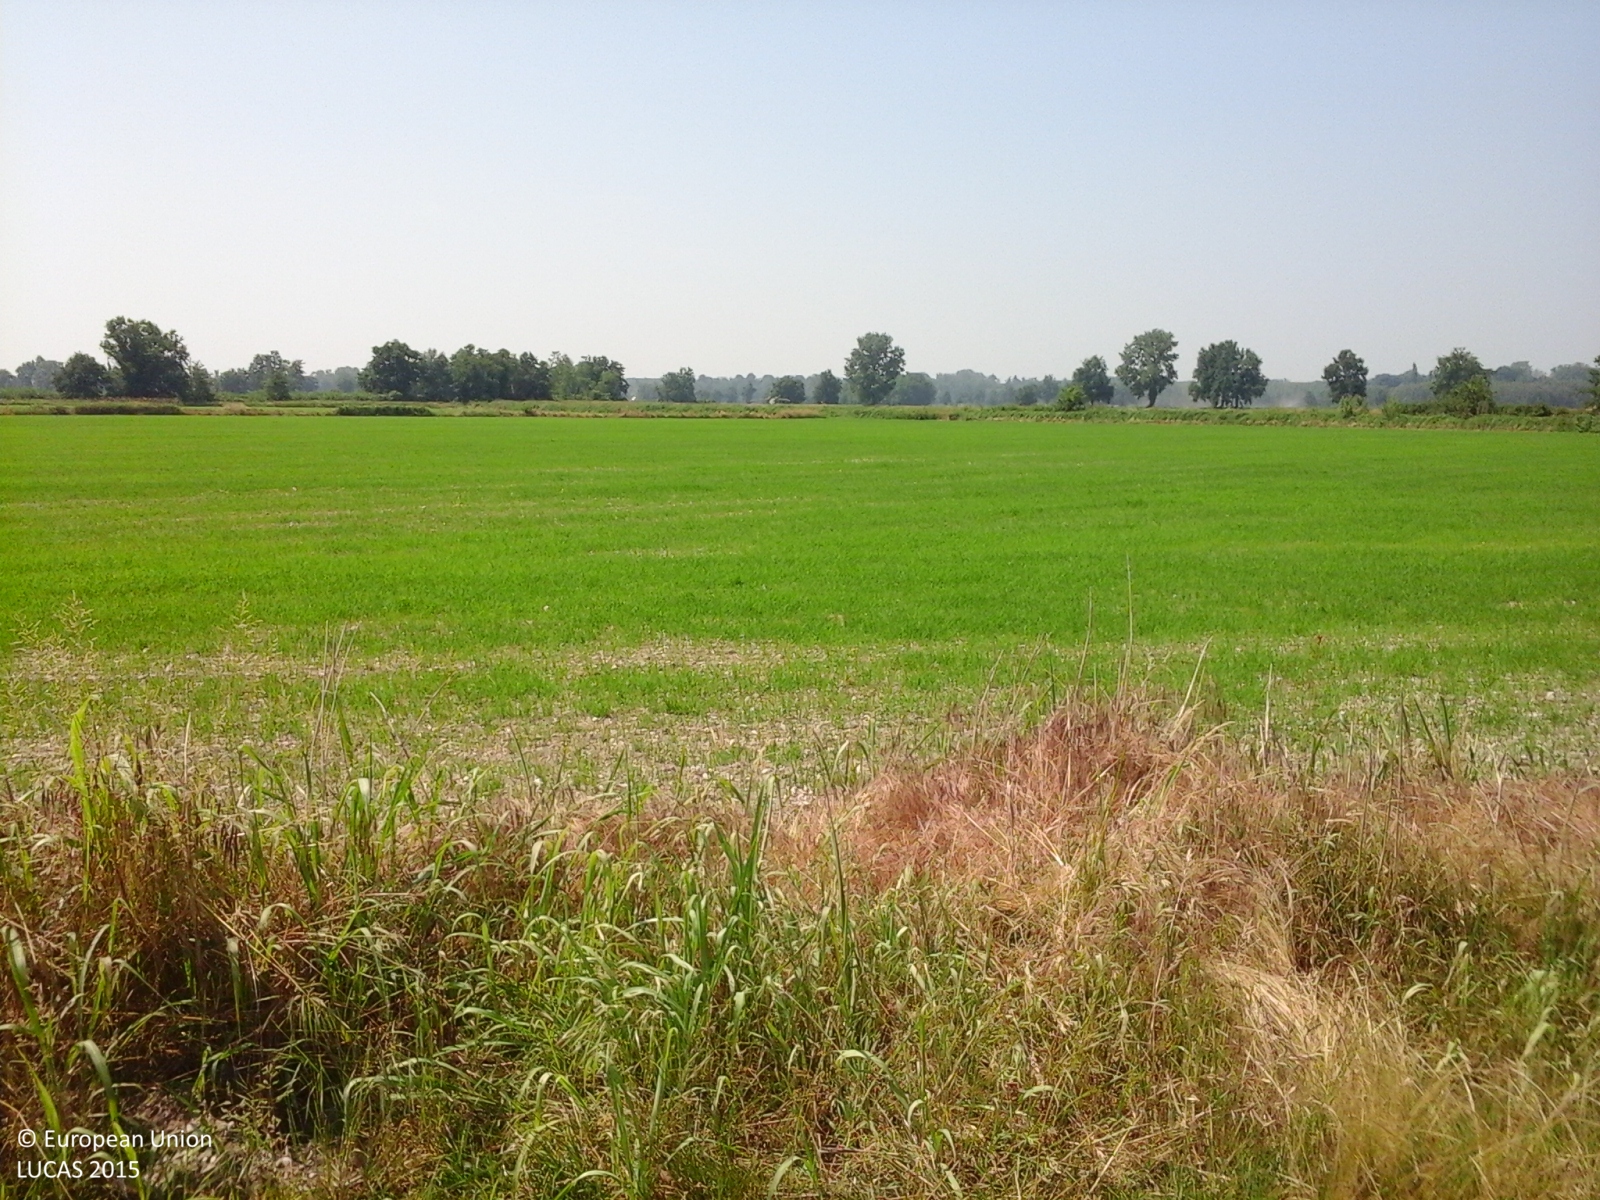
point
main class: Cropland
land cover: Rice
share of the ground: > 75 %
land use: Agriculture (excluding fallow land and kitchen gardens)
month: June
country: IT
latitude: 45.2826
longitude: 8.9183
